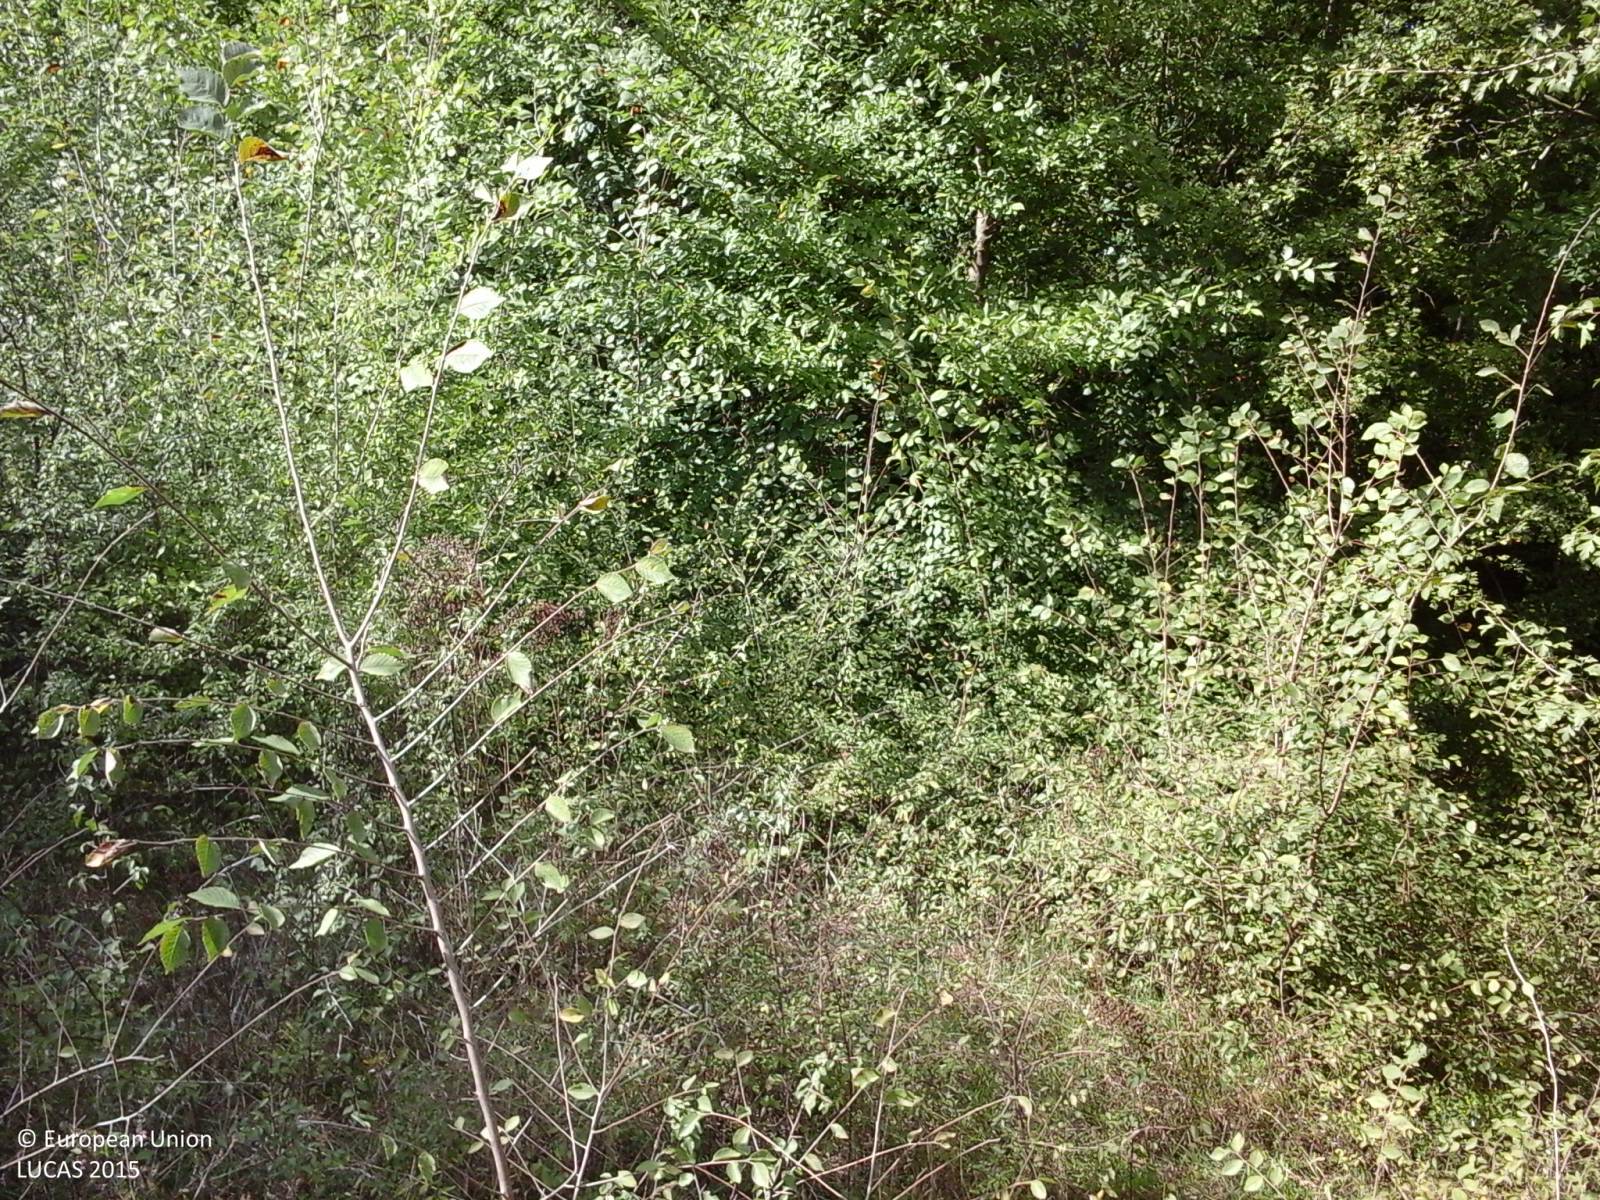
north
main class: Shrubland
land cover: Shrubland with sparse tree cover
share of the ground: > 75 %
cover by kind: shrubs 95 %, broadleaved forest trees 5 %
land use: Abandoned areas
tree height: < 5 m
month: September
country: IT
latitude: 42.3857
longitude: 12.6027
